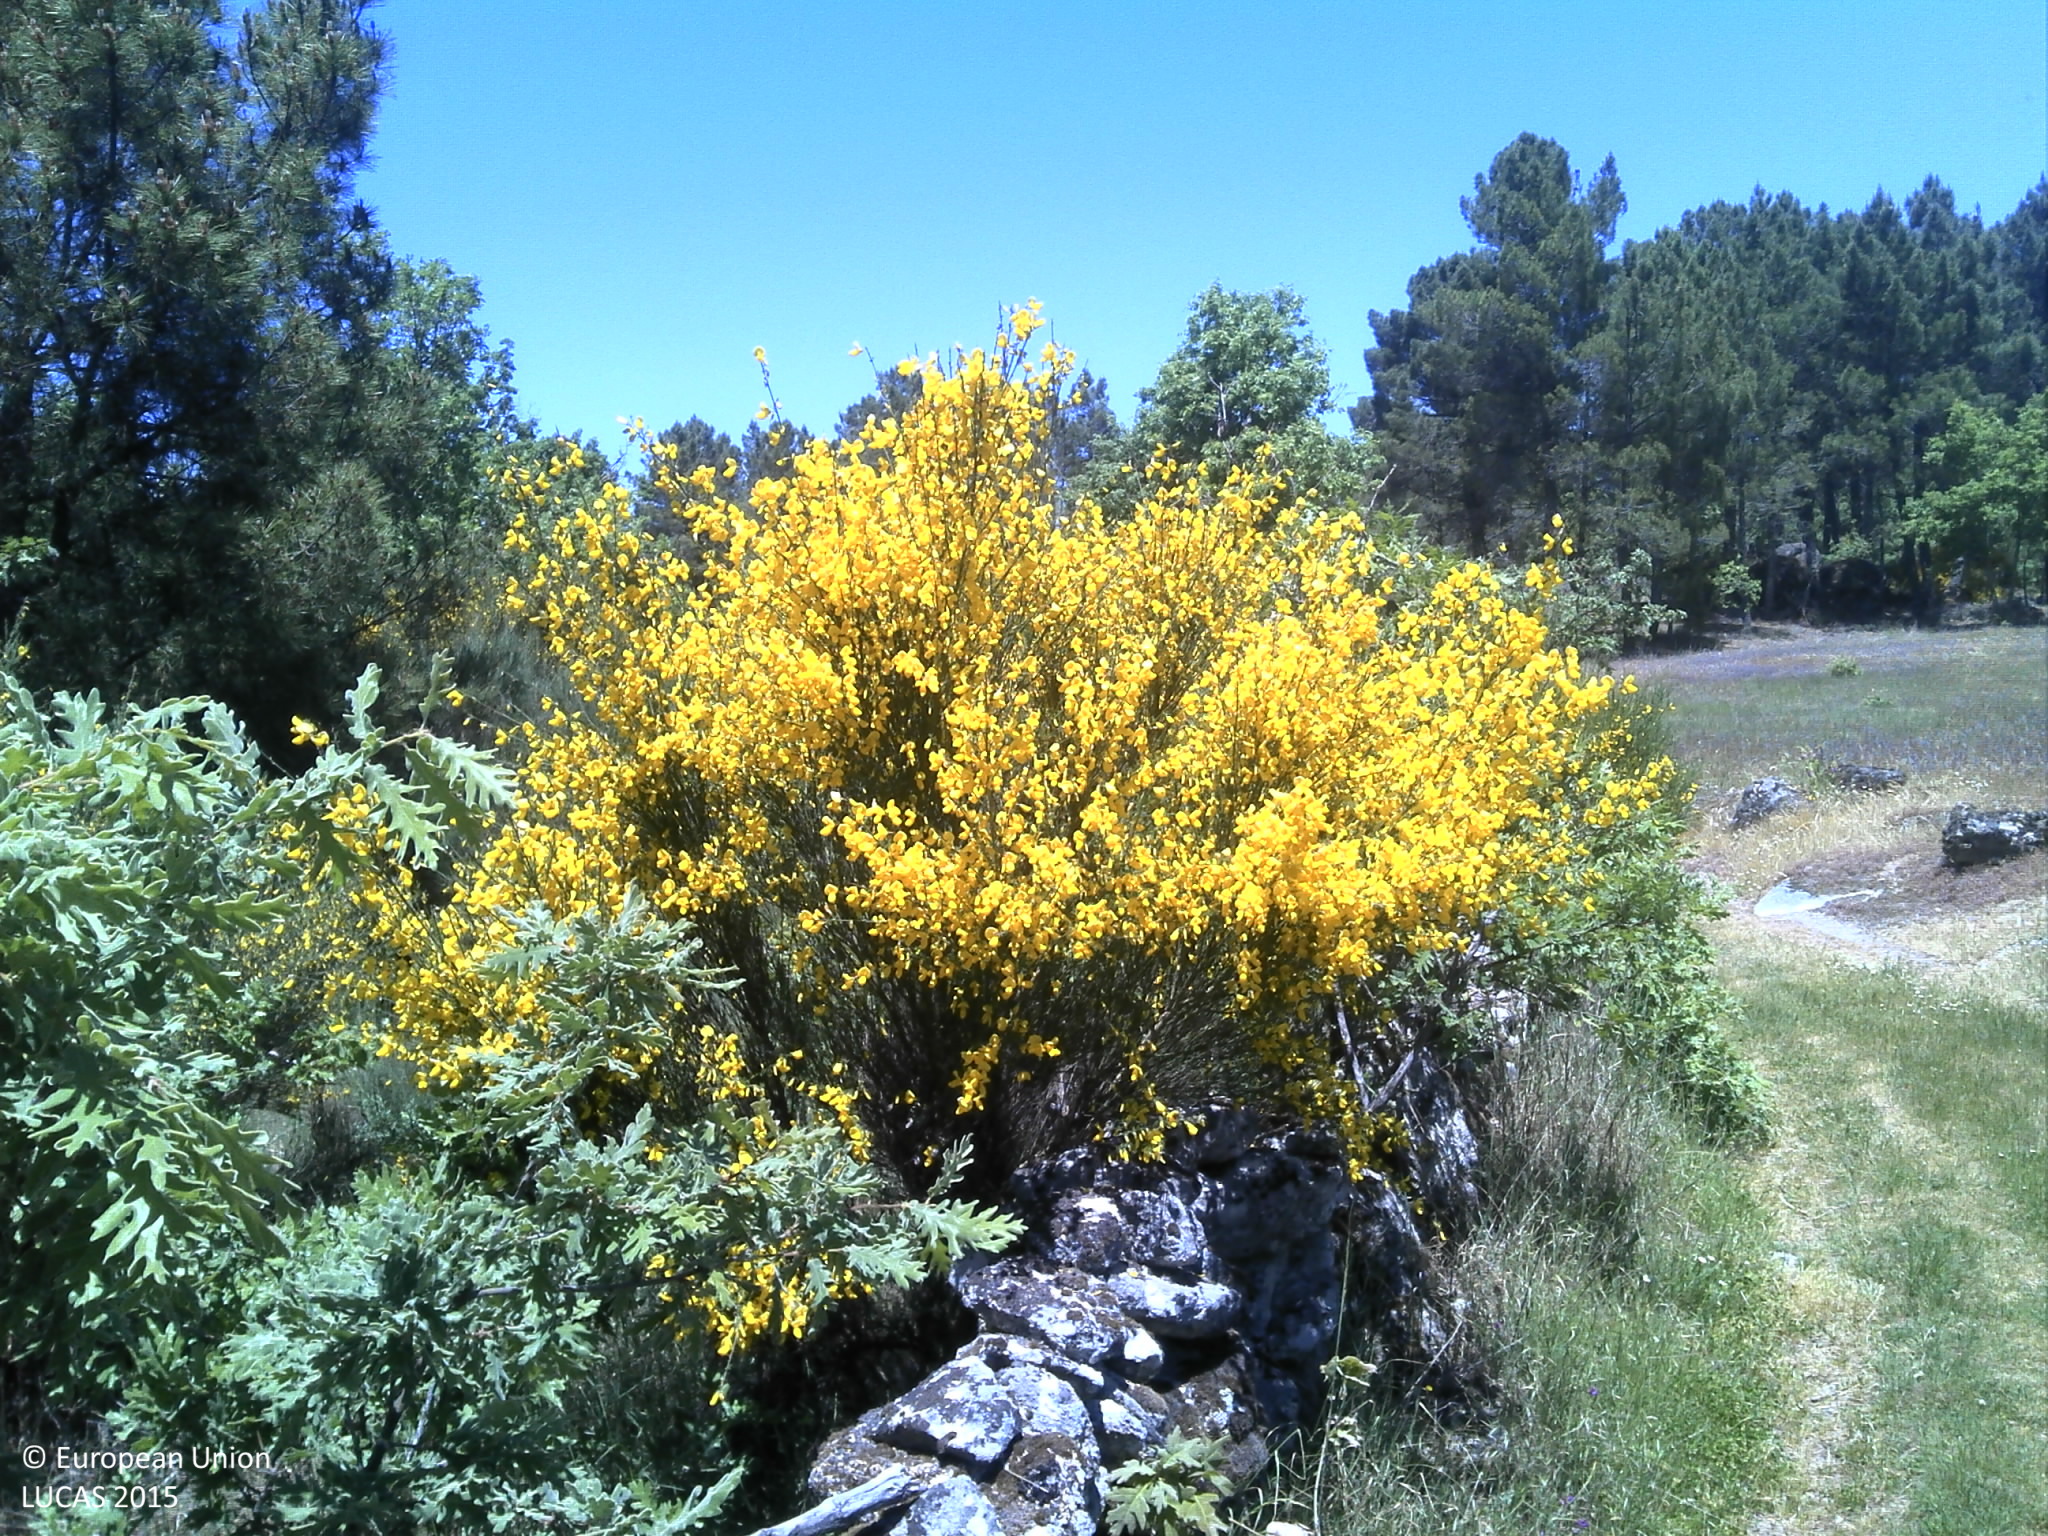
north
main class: Shrubland
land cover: Shrubland with sparse tree cover
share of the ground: 50 - 75 %
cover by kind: shrubs 65 %, herbaceous plants 15 %, unconsolidated bare surface 10 %, broadleaved forest trees 5 %
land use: Semi-natural and natural areas not in use
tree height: > 5 m
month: May
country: PT
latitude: 40.5664
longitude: -7.1715
